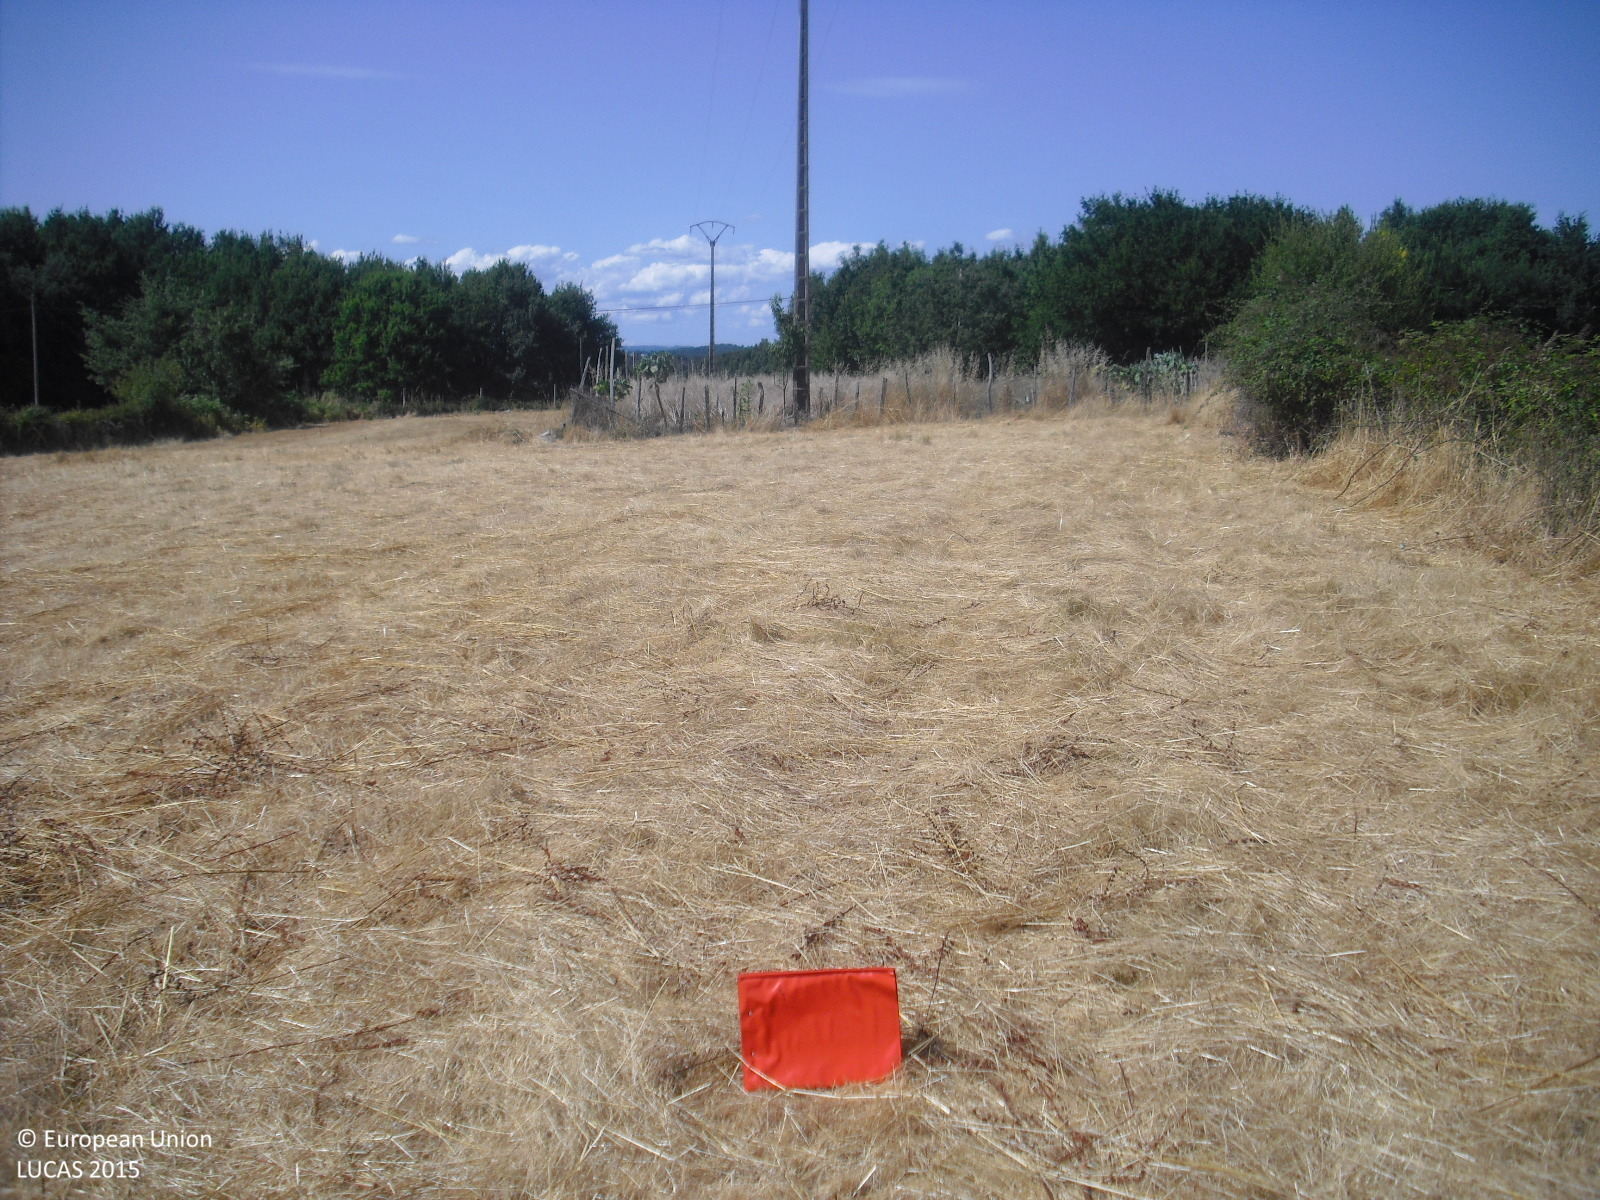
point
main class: Grassland
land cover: Grassland without tree/shrub cover
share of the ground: > 75 %
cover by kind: herbaceous plants 100 %
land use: Agriculture (excluding fallow land and kitchen gardens)
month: July
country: ES
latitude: 42.2725
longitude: -7.7383
